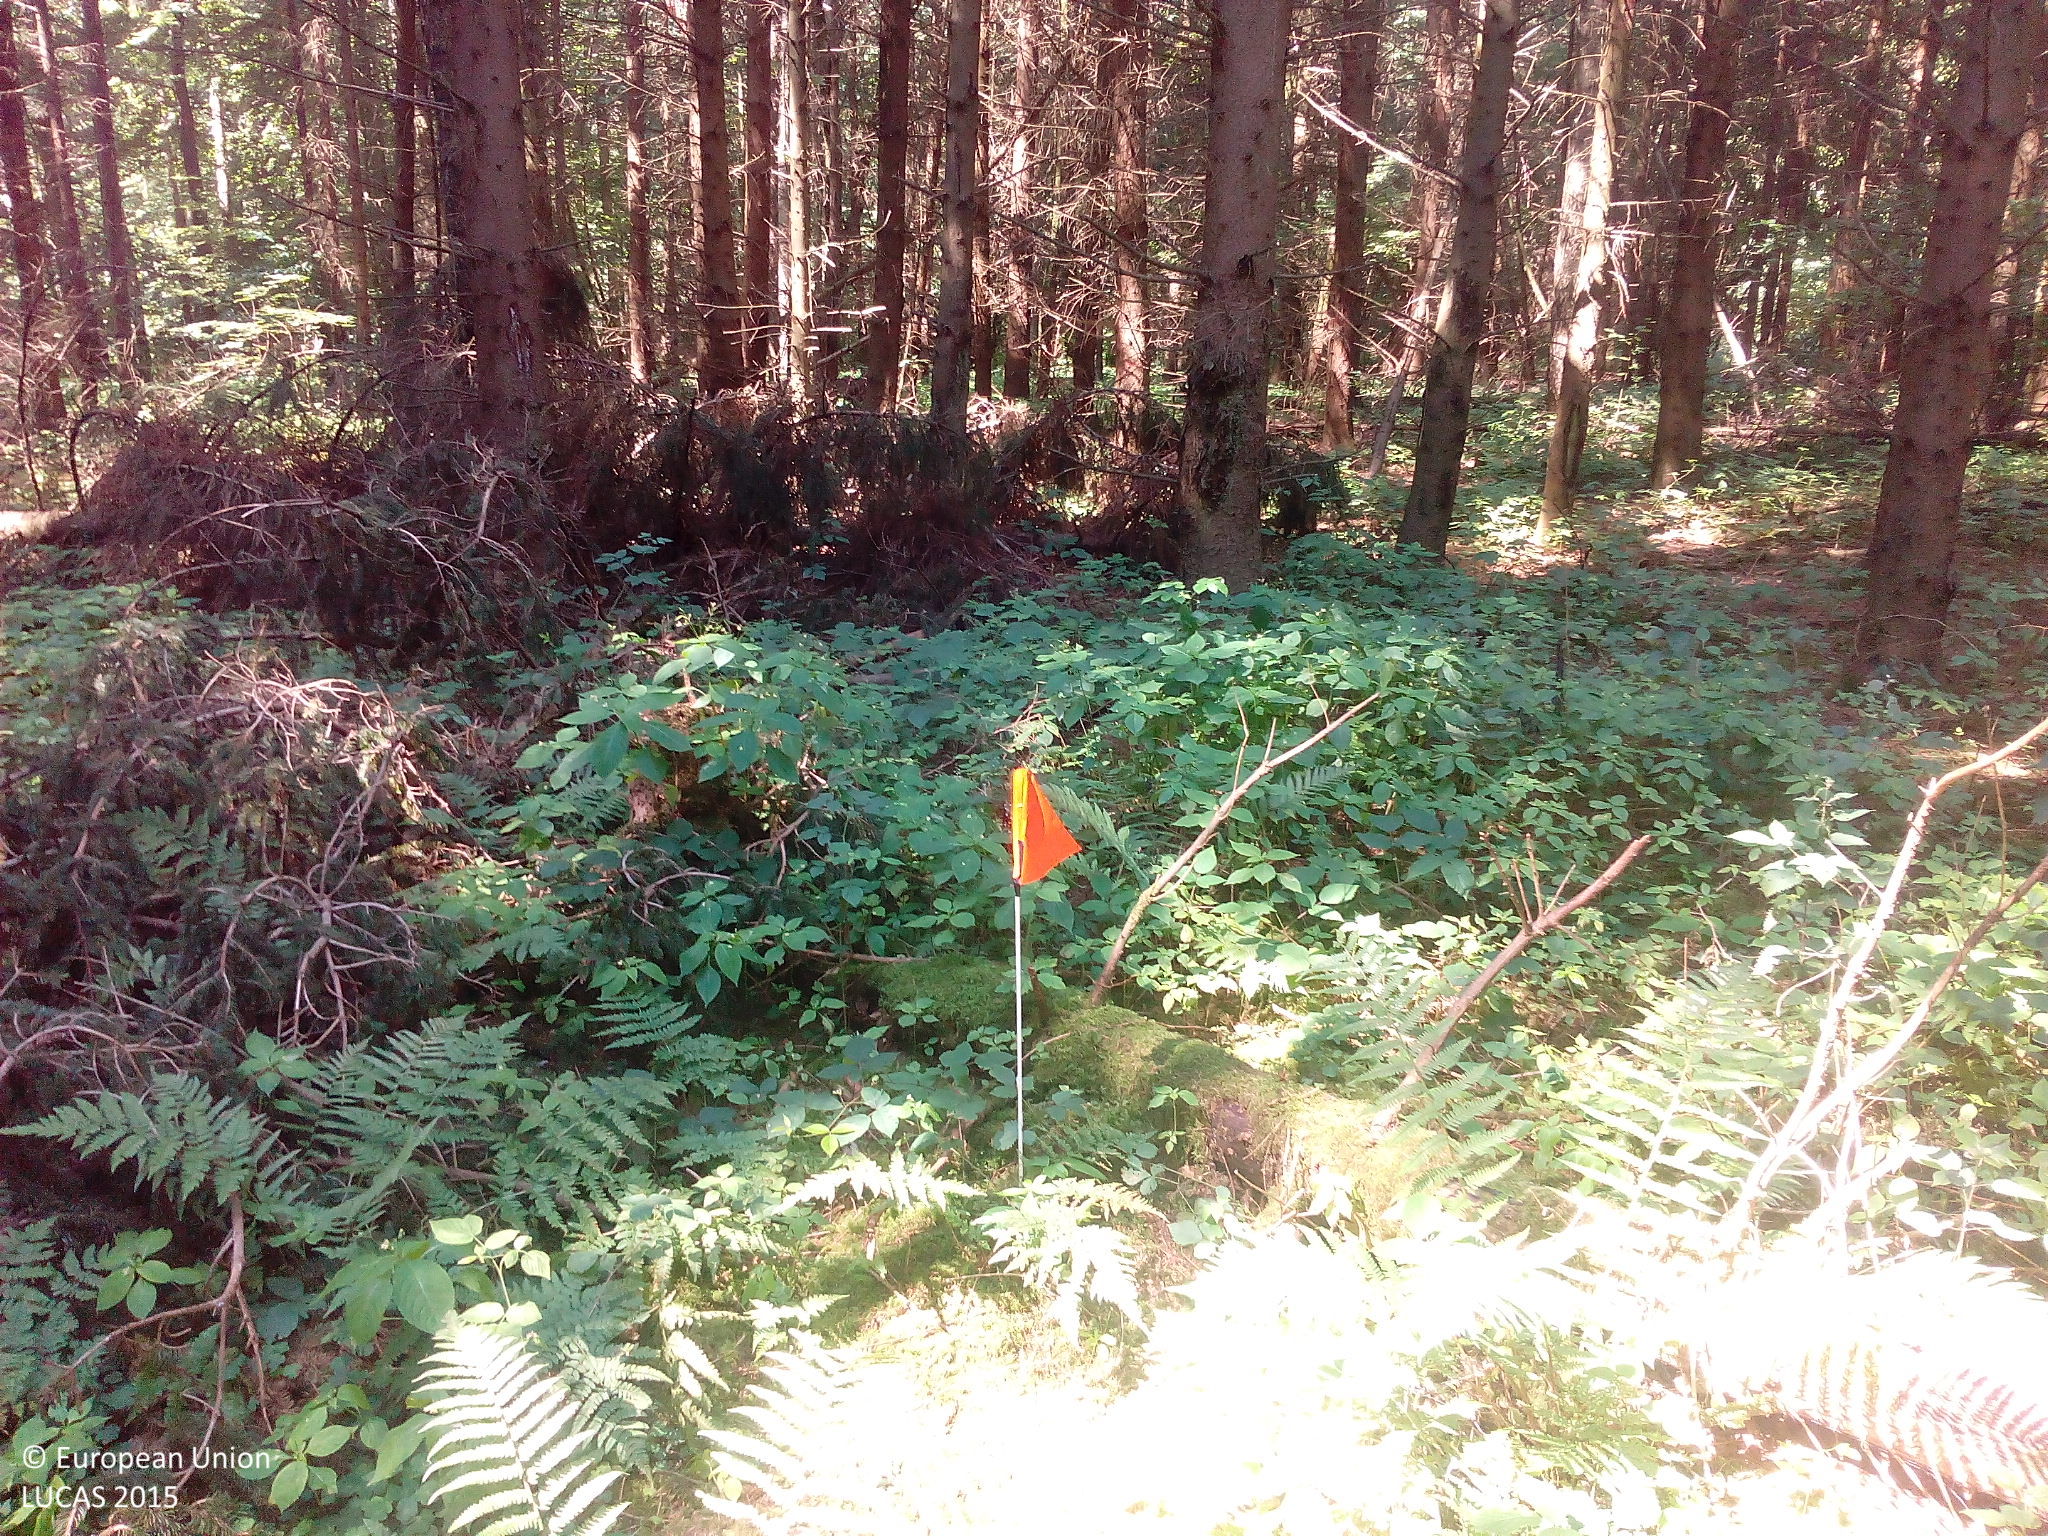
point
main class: Woodland
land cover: Spruce dominated coniferous woodland
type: hemiboreal forest and nemoral coniferous forest and mixed broadleaved-coniferous forest
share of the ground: > 75 %
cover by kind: coniferous forest trees 95 %, herbaceous plants 5 %
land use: Forestry
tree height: > 5 m
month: August
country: DE
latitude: 53.6466
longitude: 12.4651
